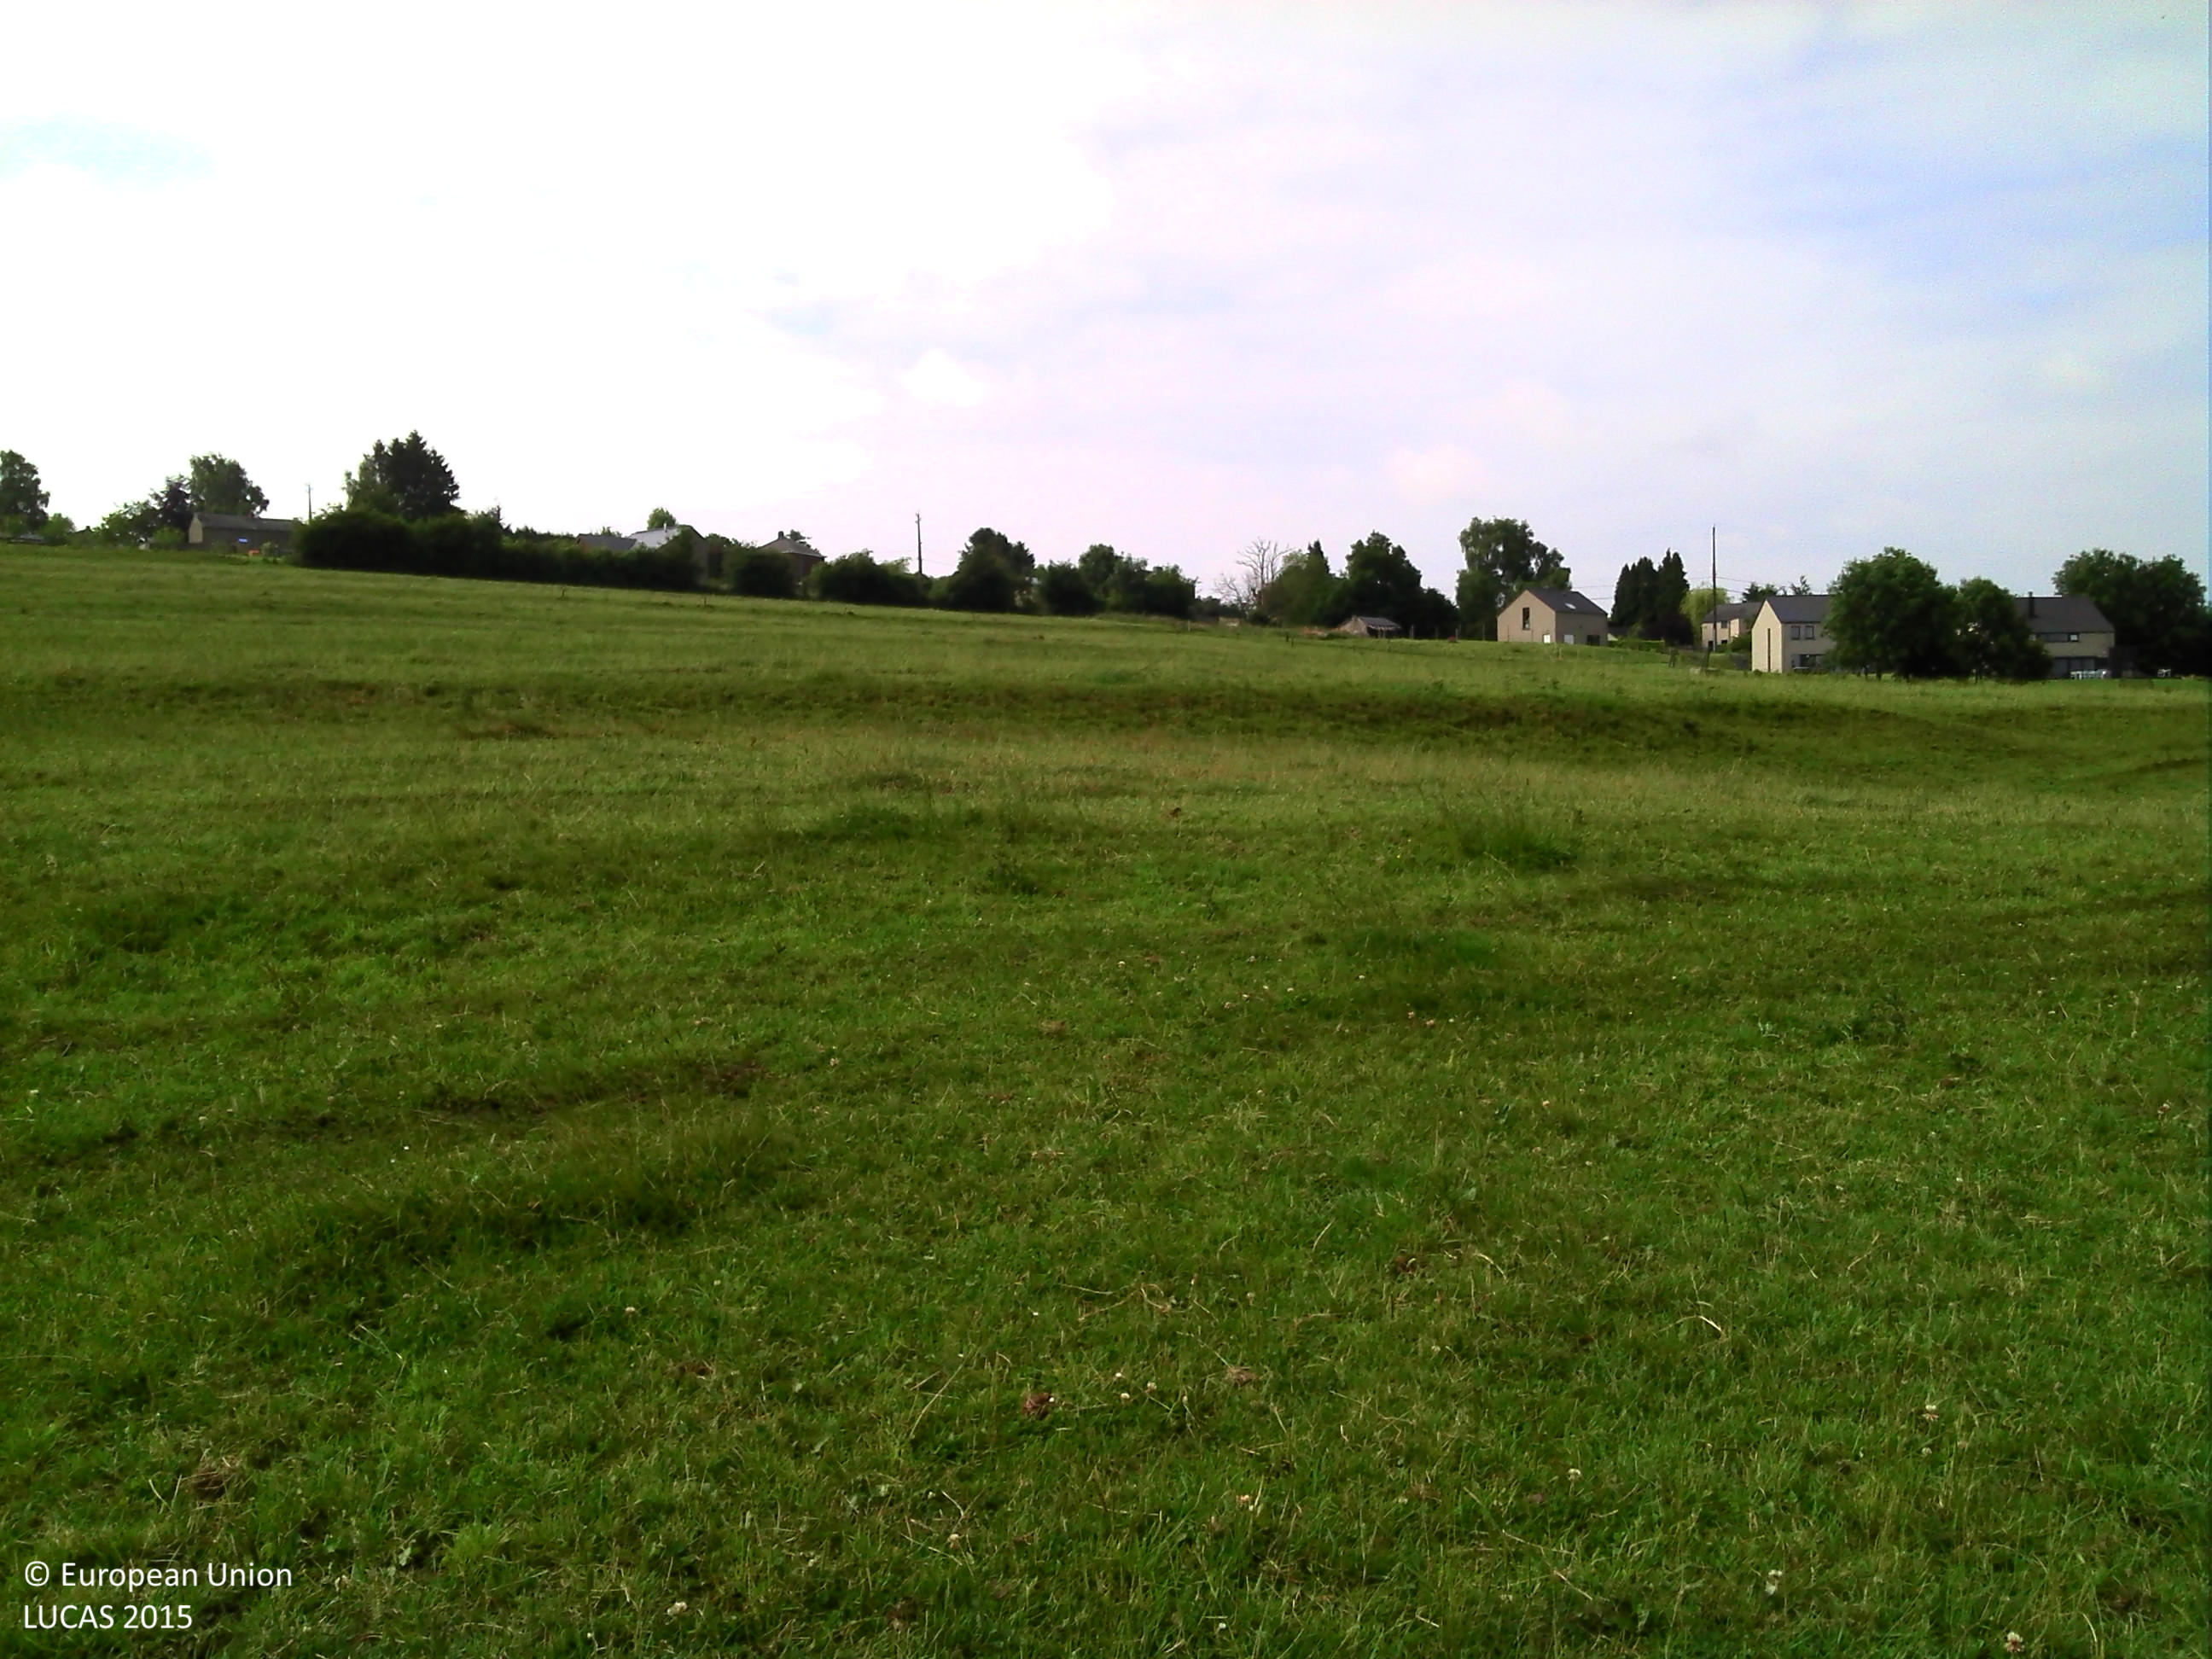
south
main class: Grassland
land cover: Grassland without tree/shrub cover
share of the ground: > 75 %
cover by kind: herbaceous plants 100 %
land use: Agriculture (excluding fallow land and kitchen gardens)
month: June
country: BE
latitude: 50.5097
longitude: 5.4999
